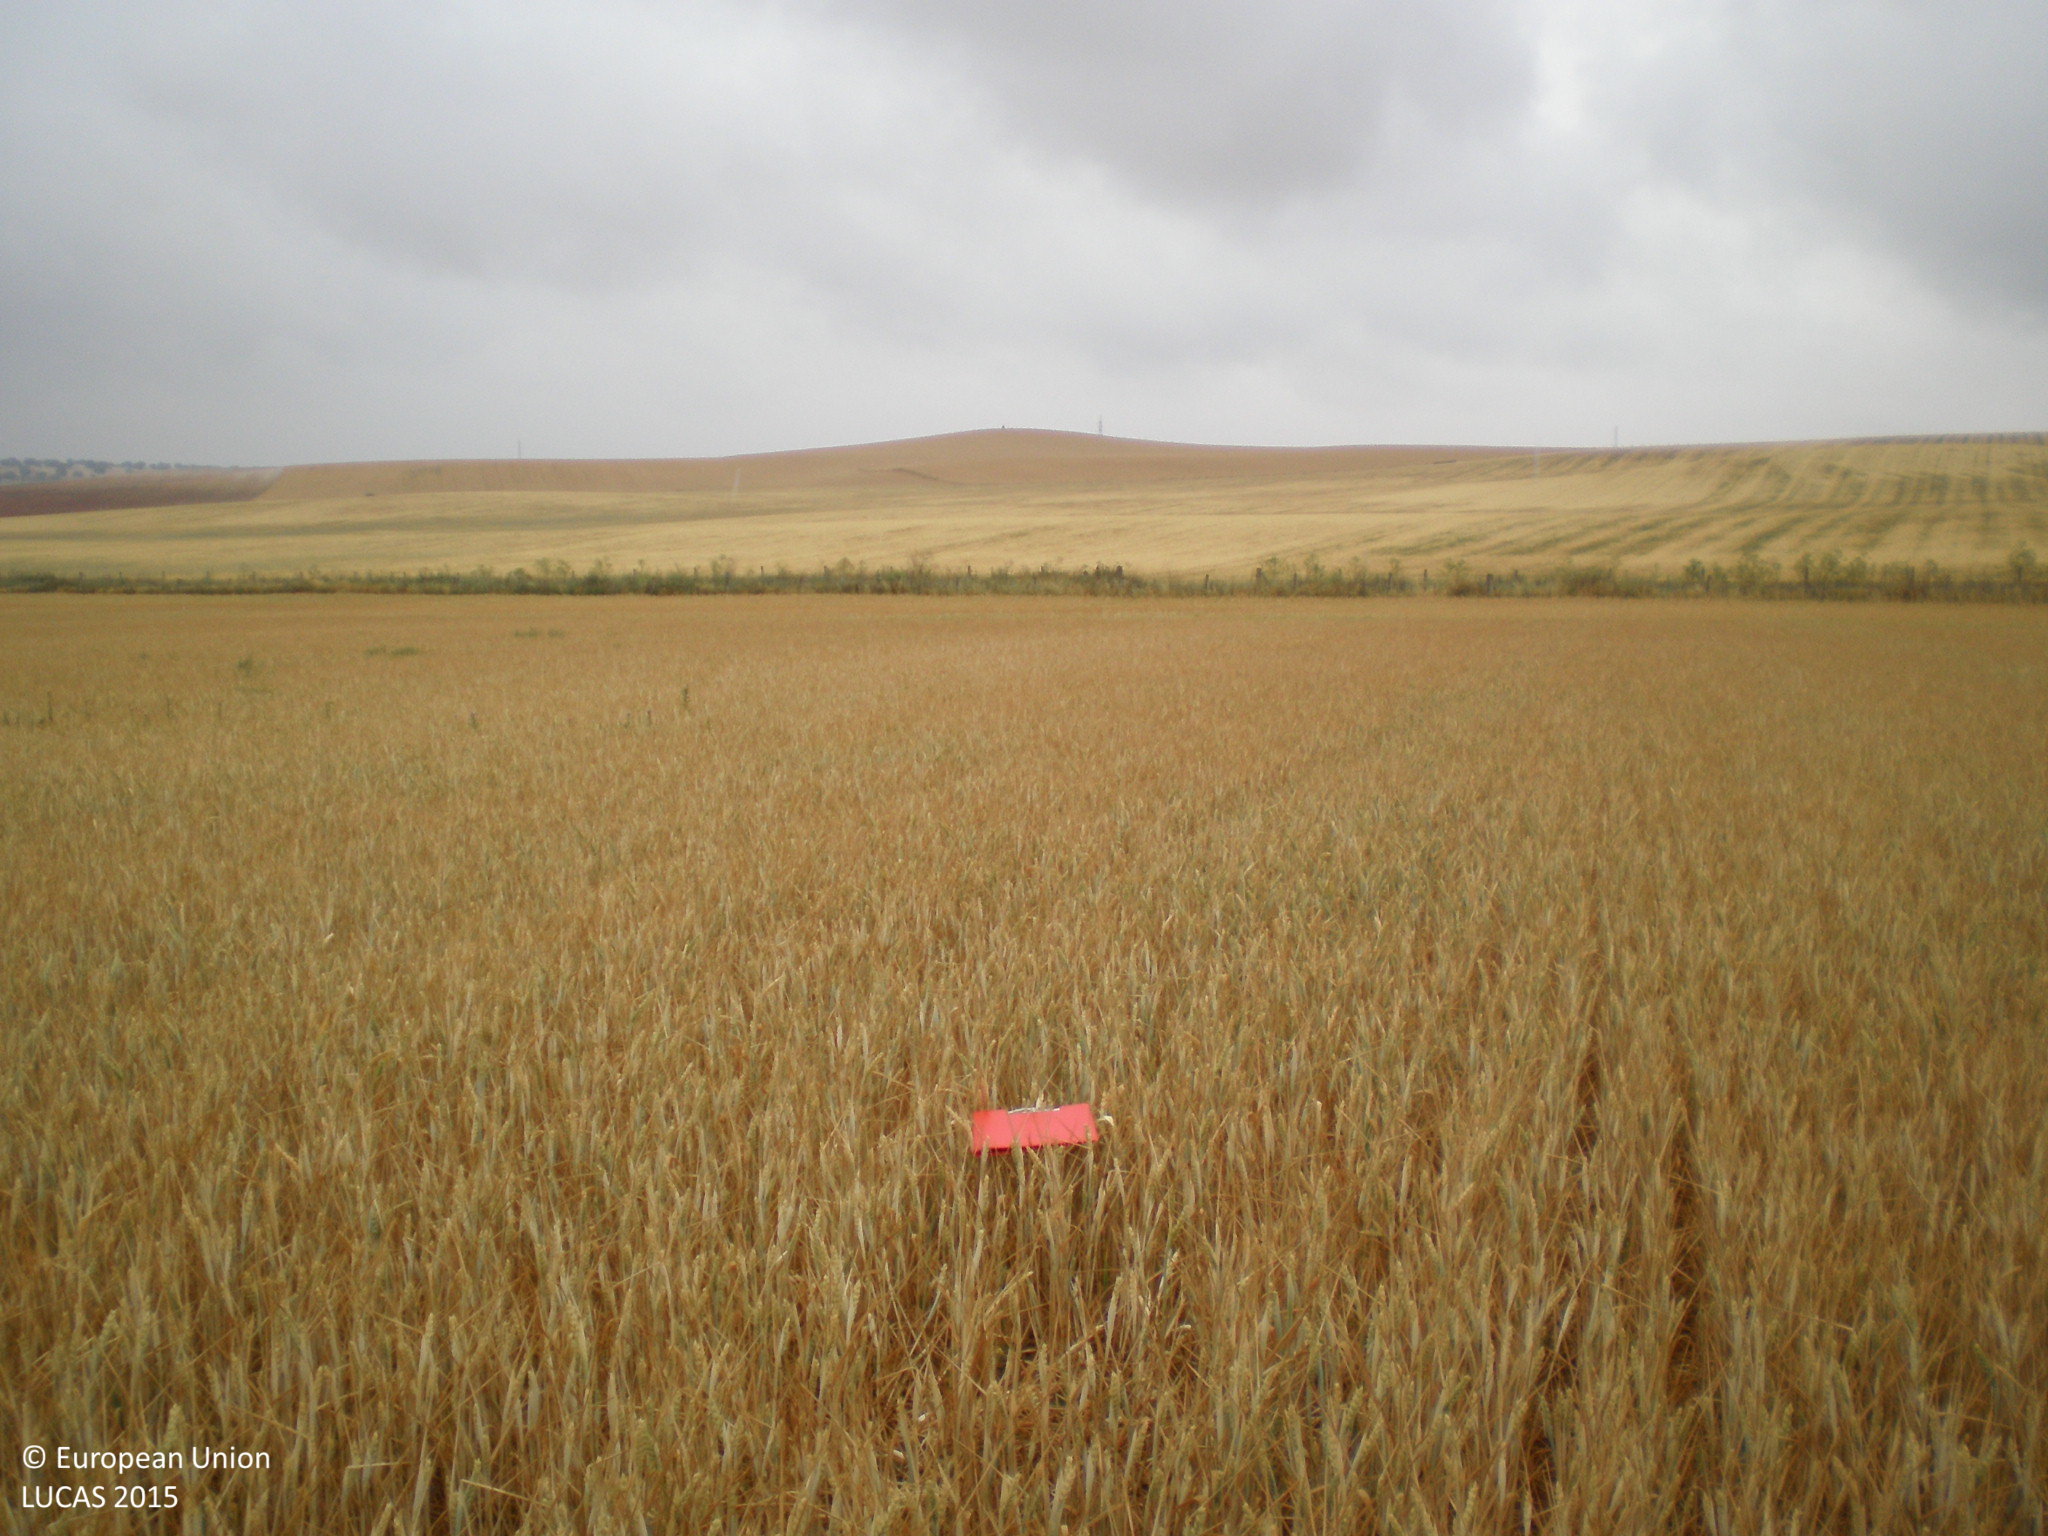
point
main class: Cropland
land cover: Common wheat
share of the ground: > 75 %
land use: Agriculture (excluding fallow land and kitchen gardens)
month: June
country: ES
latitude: 40.9714
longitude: -5.7532
